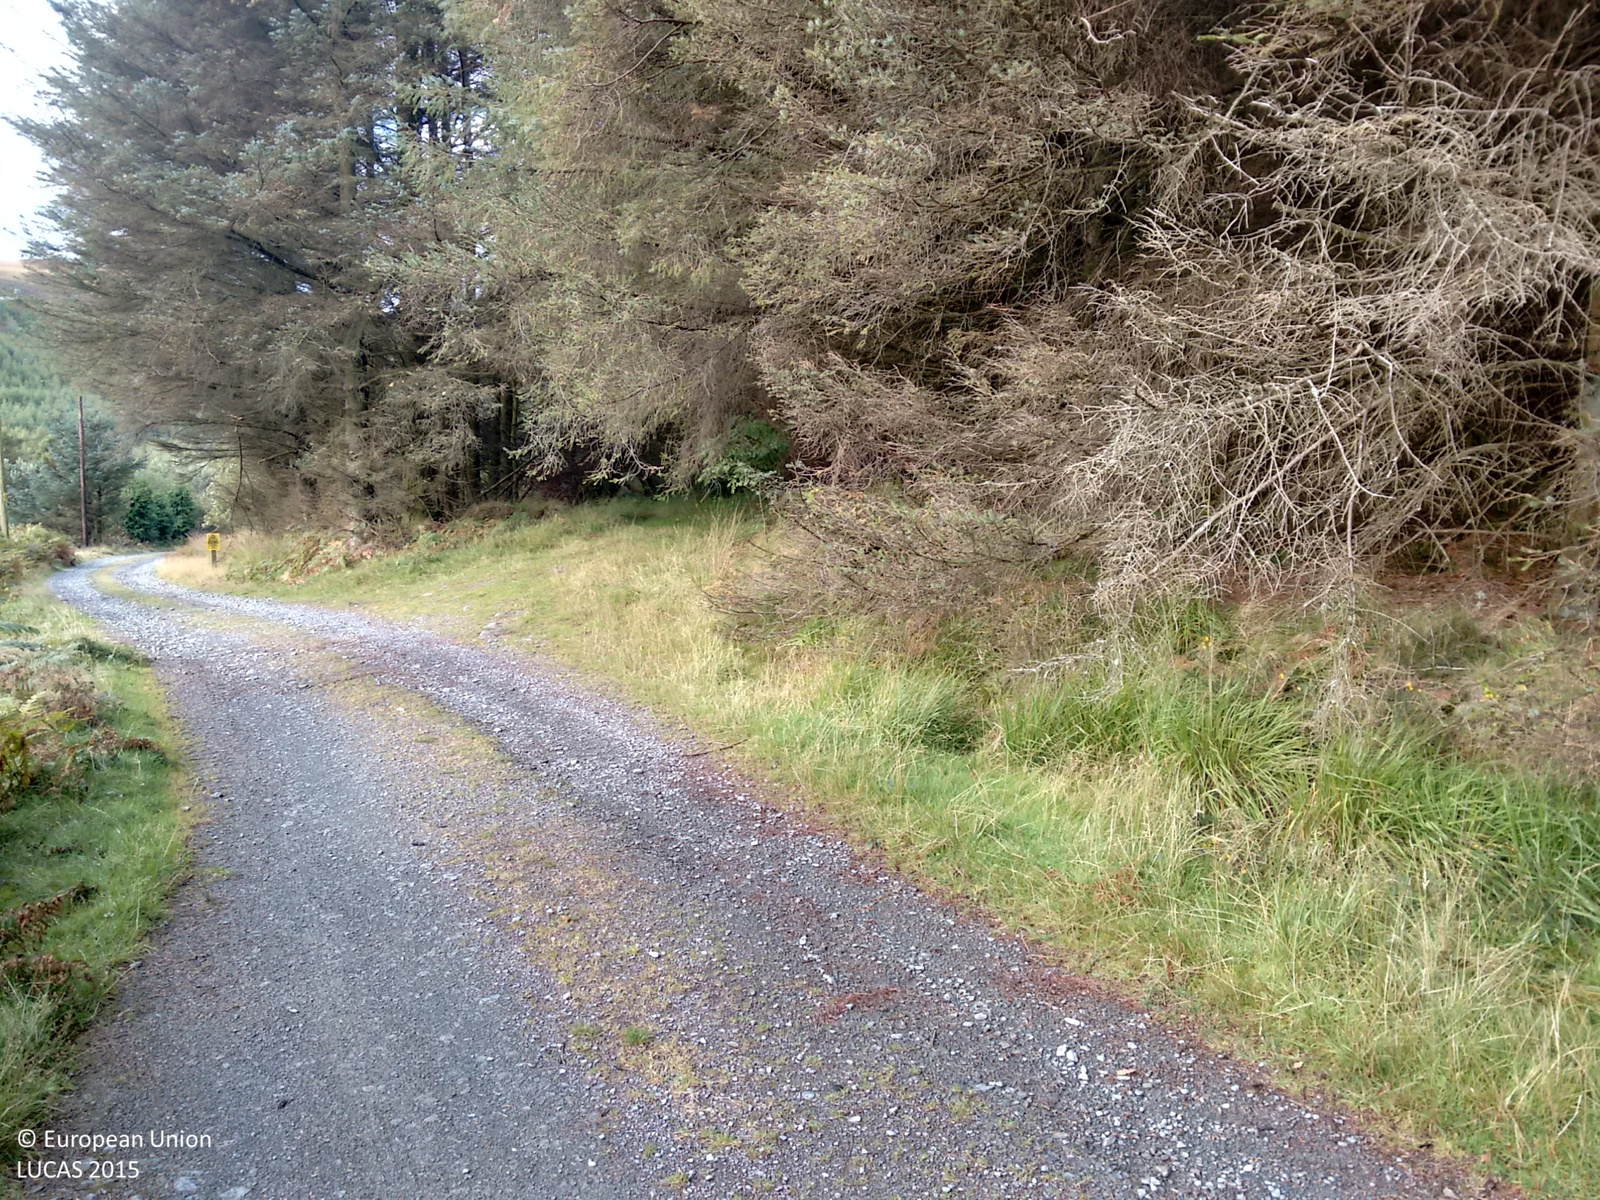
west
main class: Shrubland
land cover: Shrubland without tree cover
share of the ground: > 75 %
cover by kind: shrubs 100 %
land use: Semi-natural and natural areas not in use
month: October
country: GB
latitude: 52.4689
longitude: -3.8851
